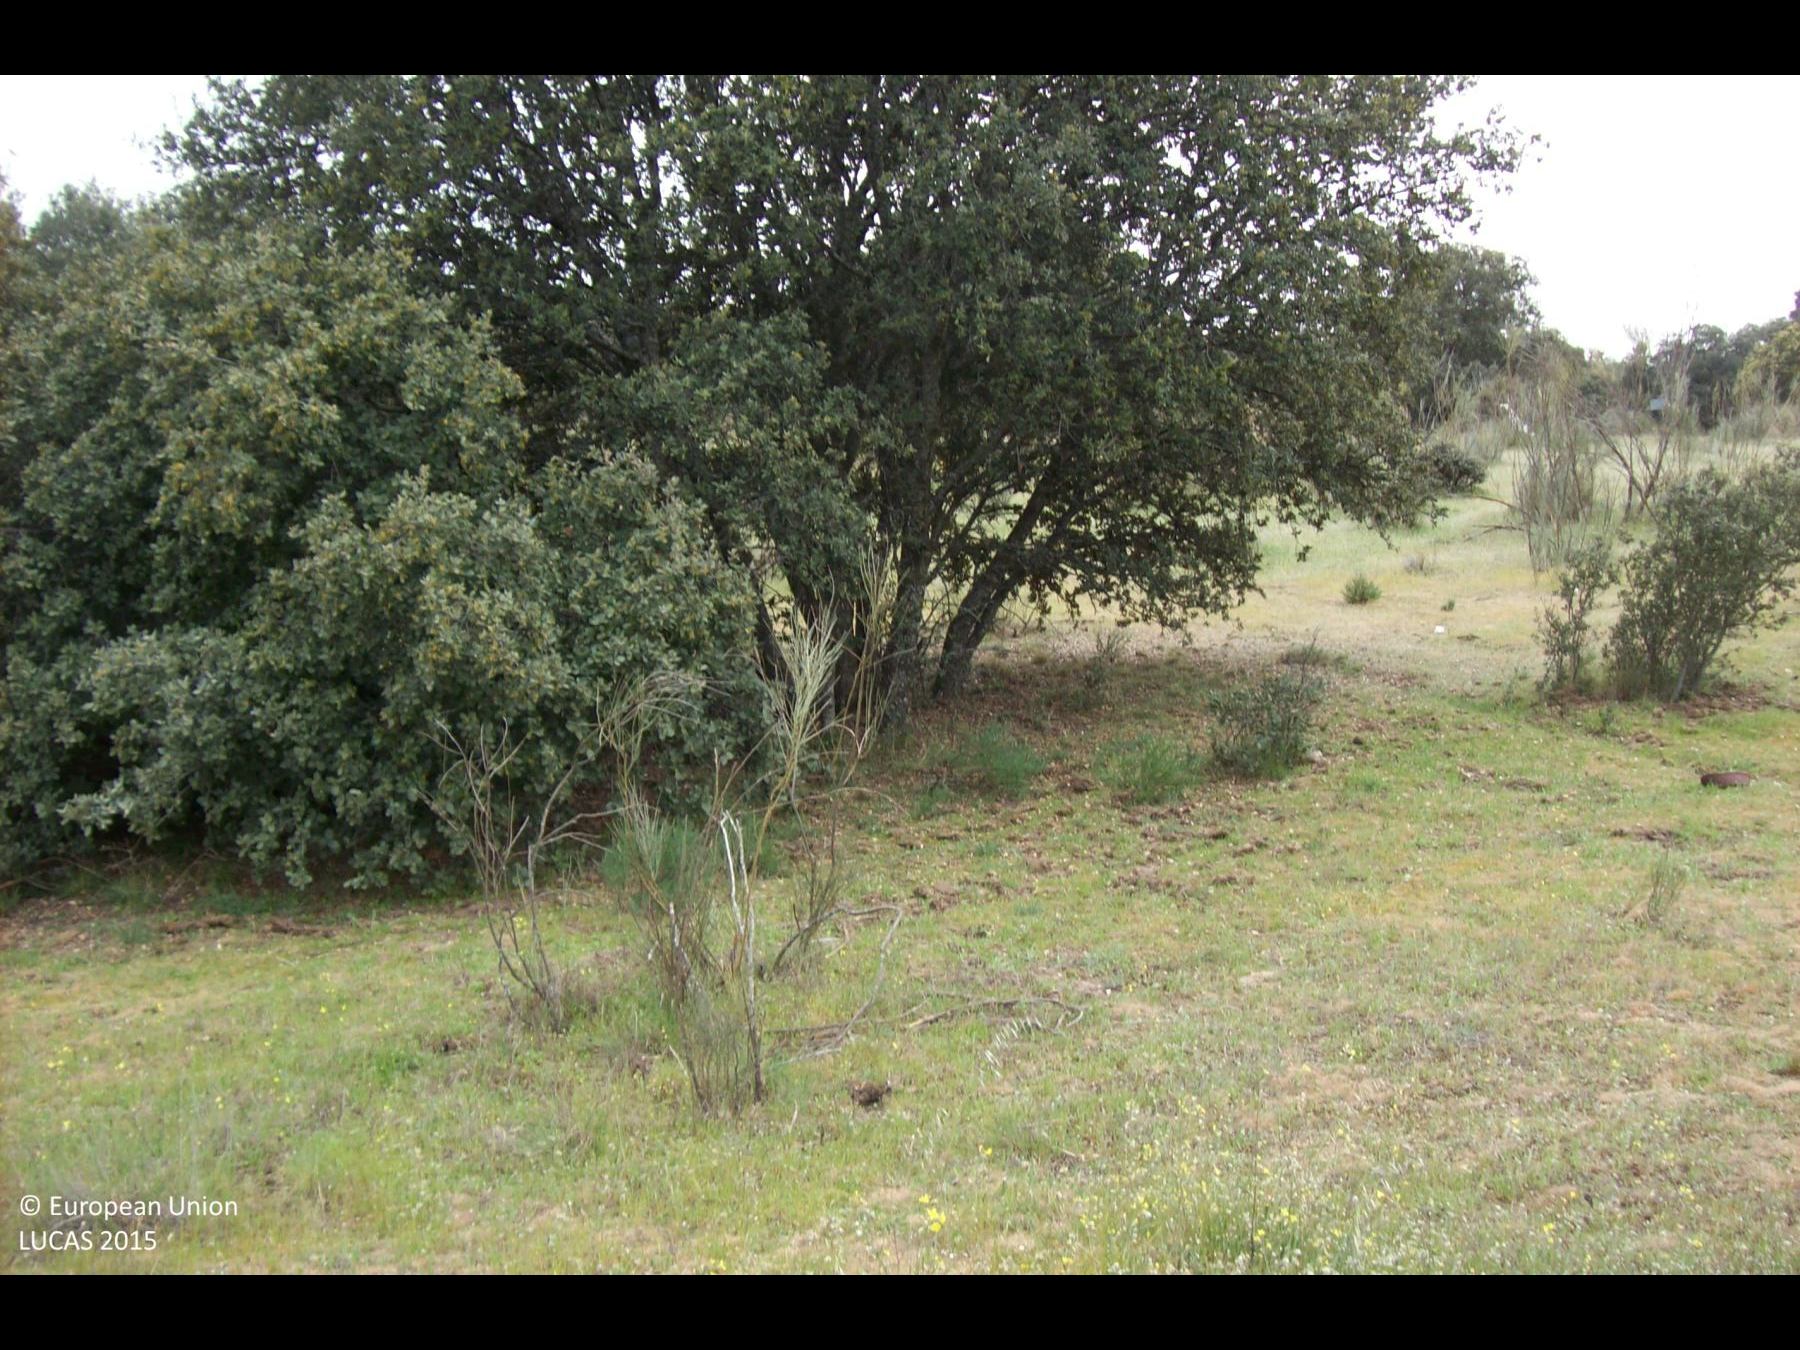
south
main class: Woodland
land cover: Broadleaved woodland
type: broadleaved evergreen forest
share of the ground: 25 - 50 %
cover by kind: herbaceous plants 65 %, broadleaved forest trees 25 %, shrubs 10 %
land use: Semi-natural and natural areas not in use
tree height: < 5 m
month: April
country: ES
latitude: 40.5106
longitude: -3.9564
